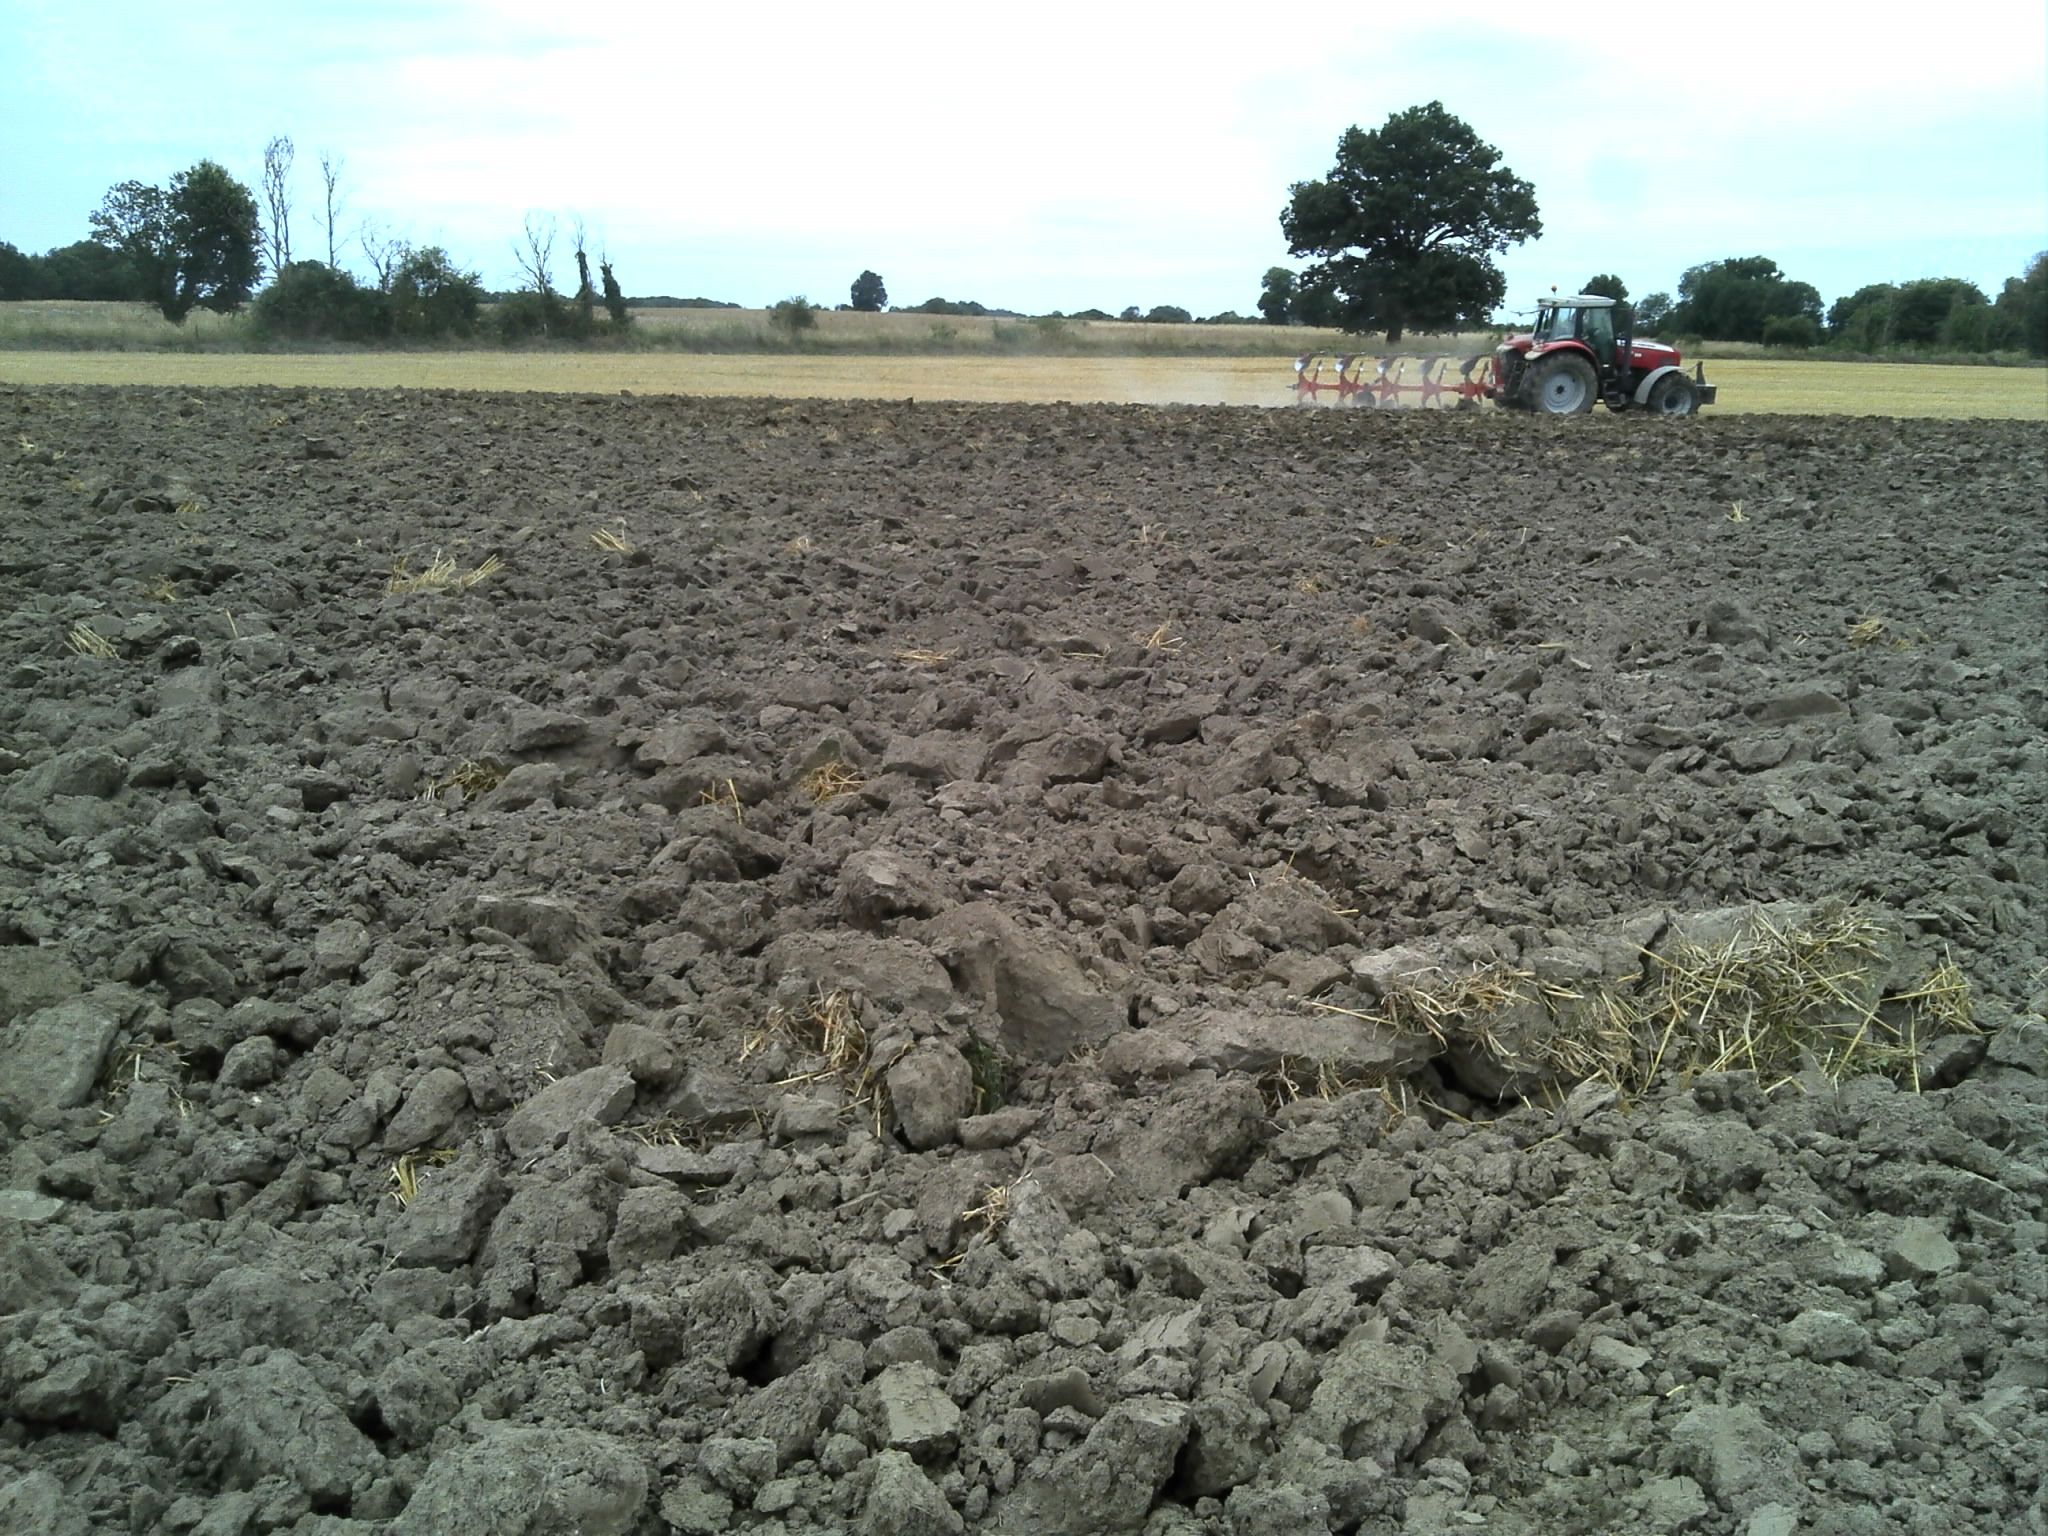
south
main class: Cropland
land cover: Barley
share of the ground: < 10 %
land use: Agriculture (excluding fallow land and kitchen gardens)
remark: Harvested field
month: July
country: FR
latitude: 46.7066
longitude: 1.5791
